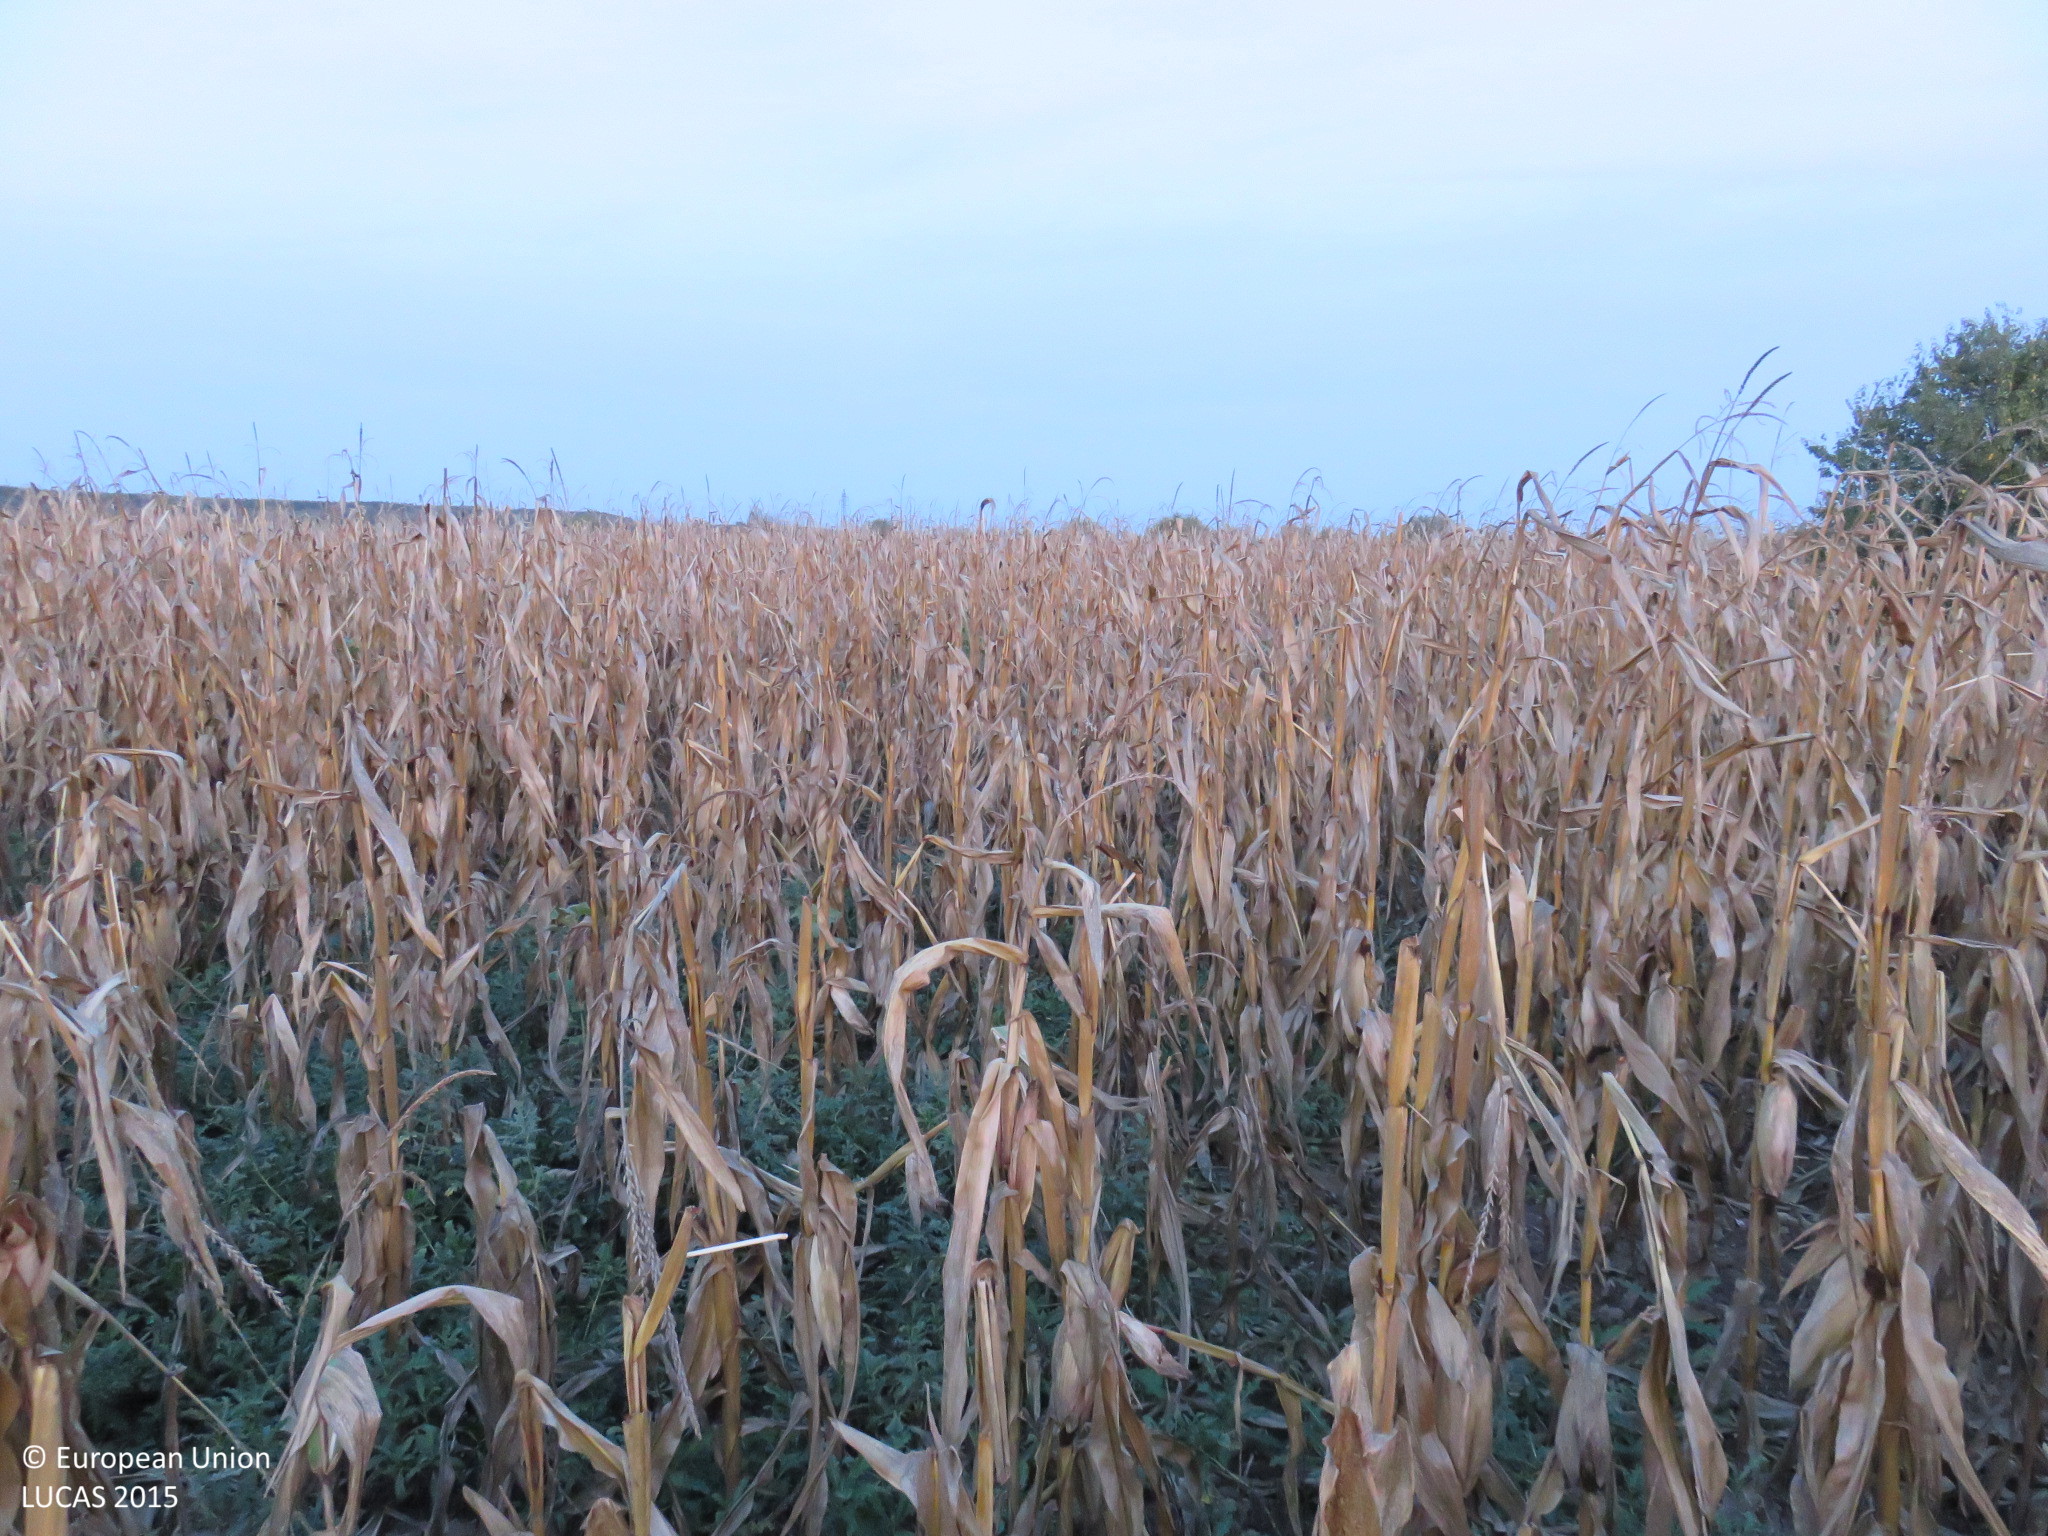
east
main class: Cropland
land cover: Maize
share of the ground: > 75 %
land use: Agriculture (excluding fallow land and kitchen gardens)
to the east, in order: Maize; Grass margins; Abandoned hedges; Ditches and canals
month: September
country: BG
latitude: 43.7319
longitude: 24.6039
